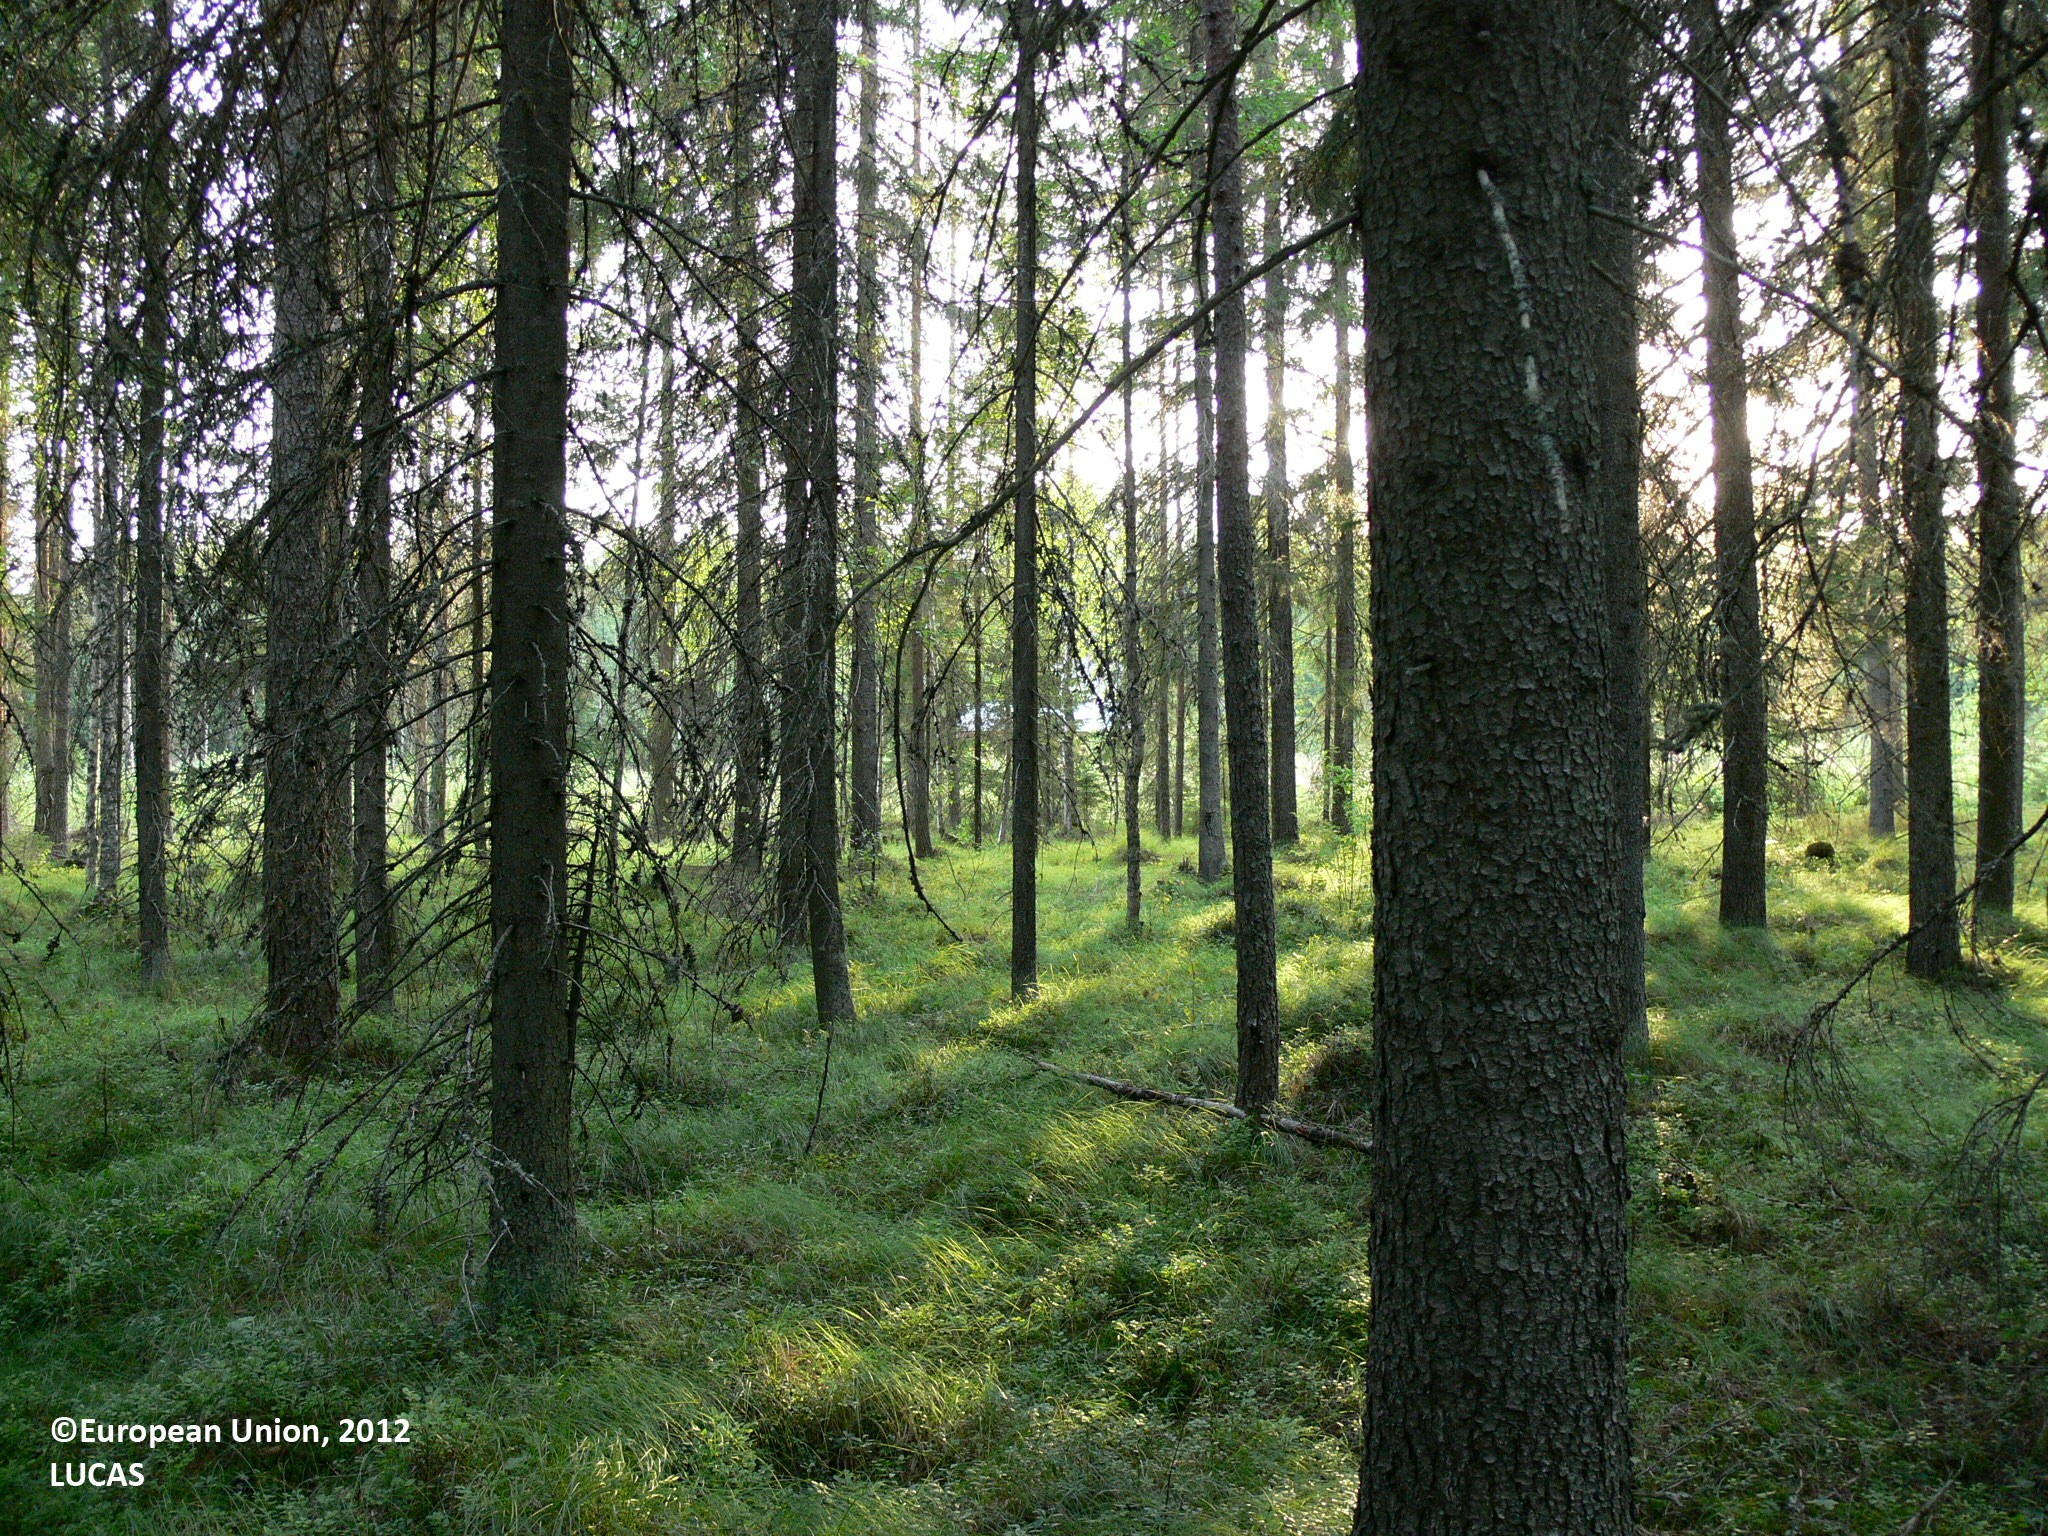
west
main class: Woodland
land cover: Spruce dominated coniferous woodland
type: boreal forest
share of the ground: > 75 %
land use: Forestry
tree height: > 5 m
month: August
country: FI
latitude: 62.1804
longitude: 30.5525
